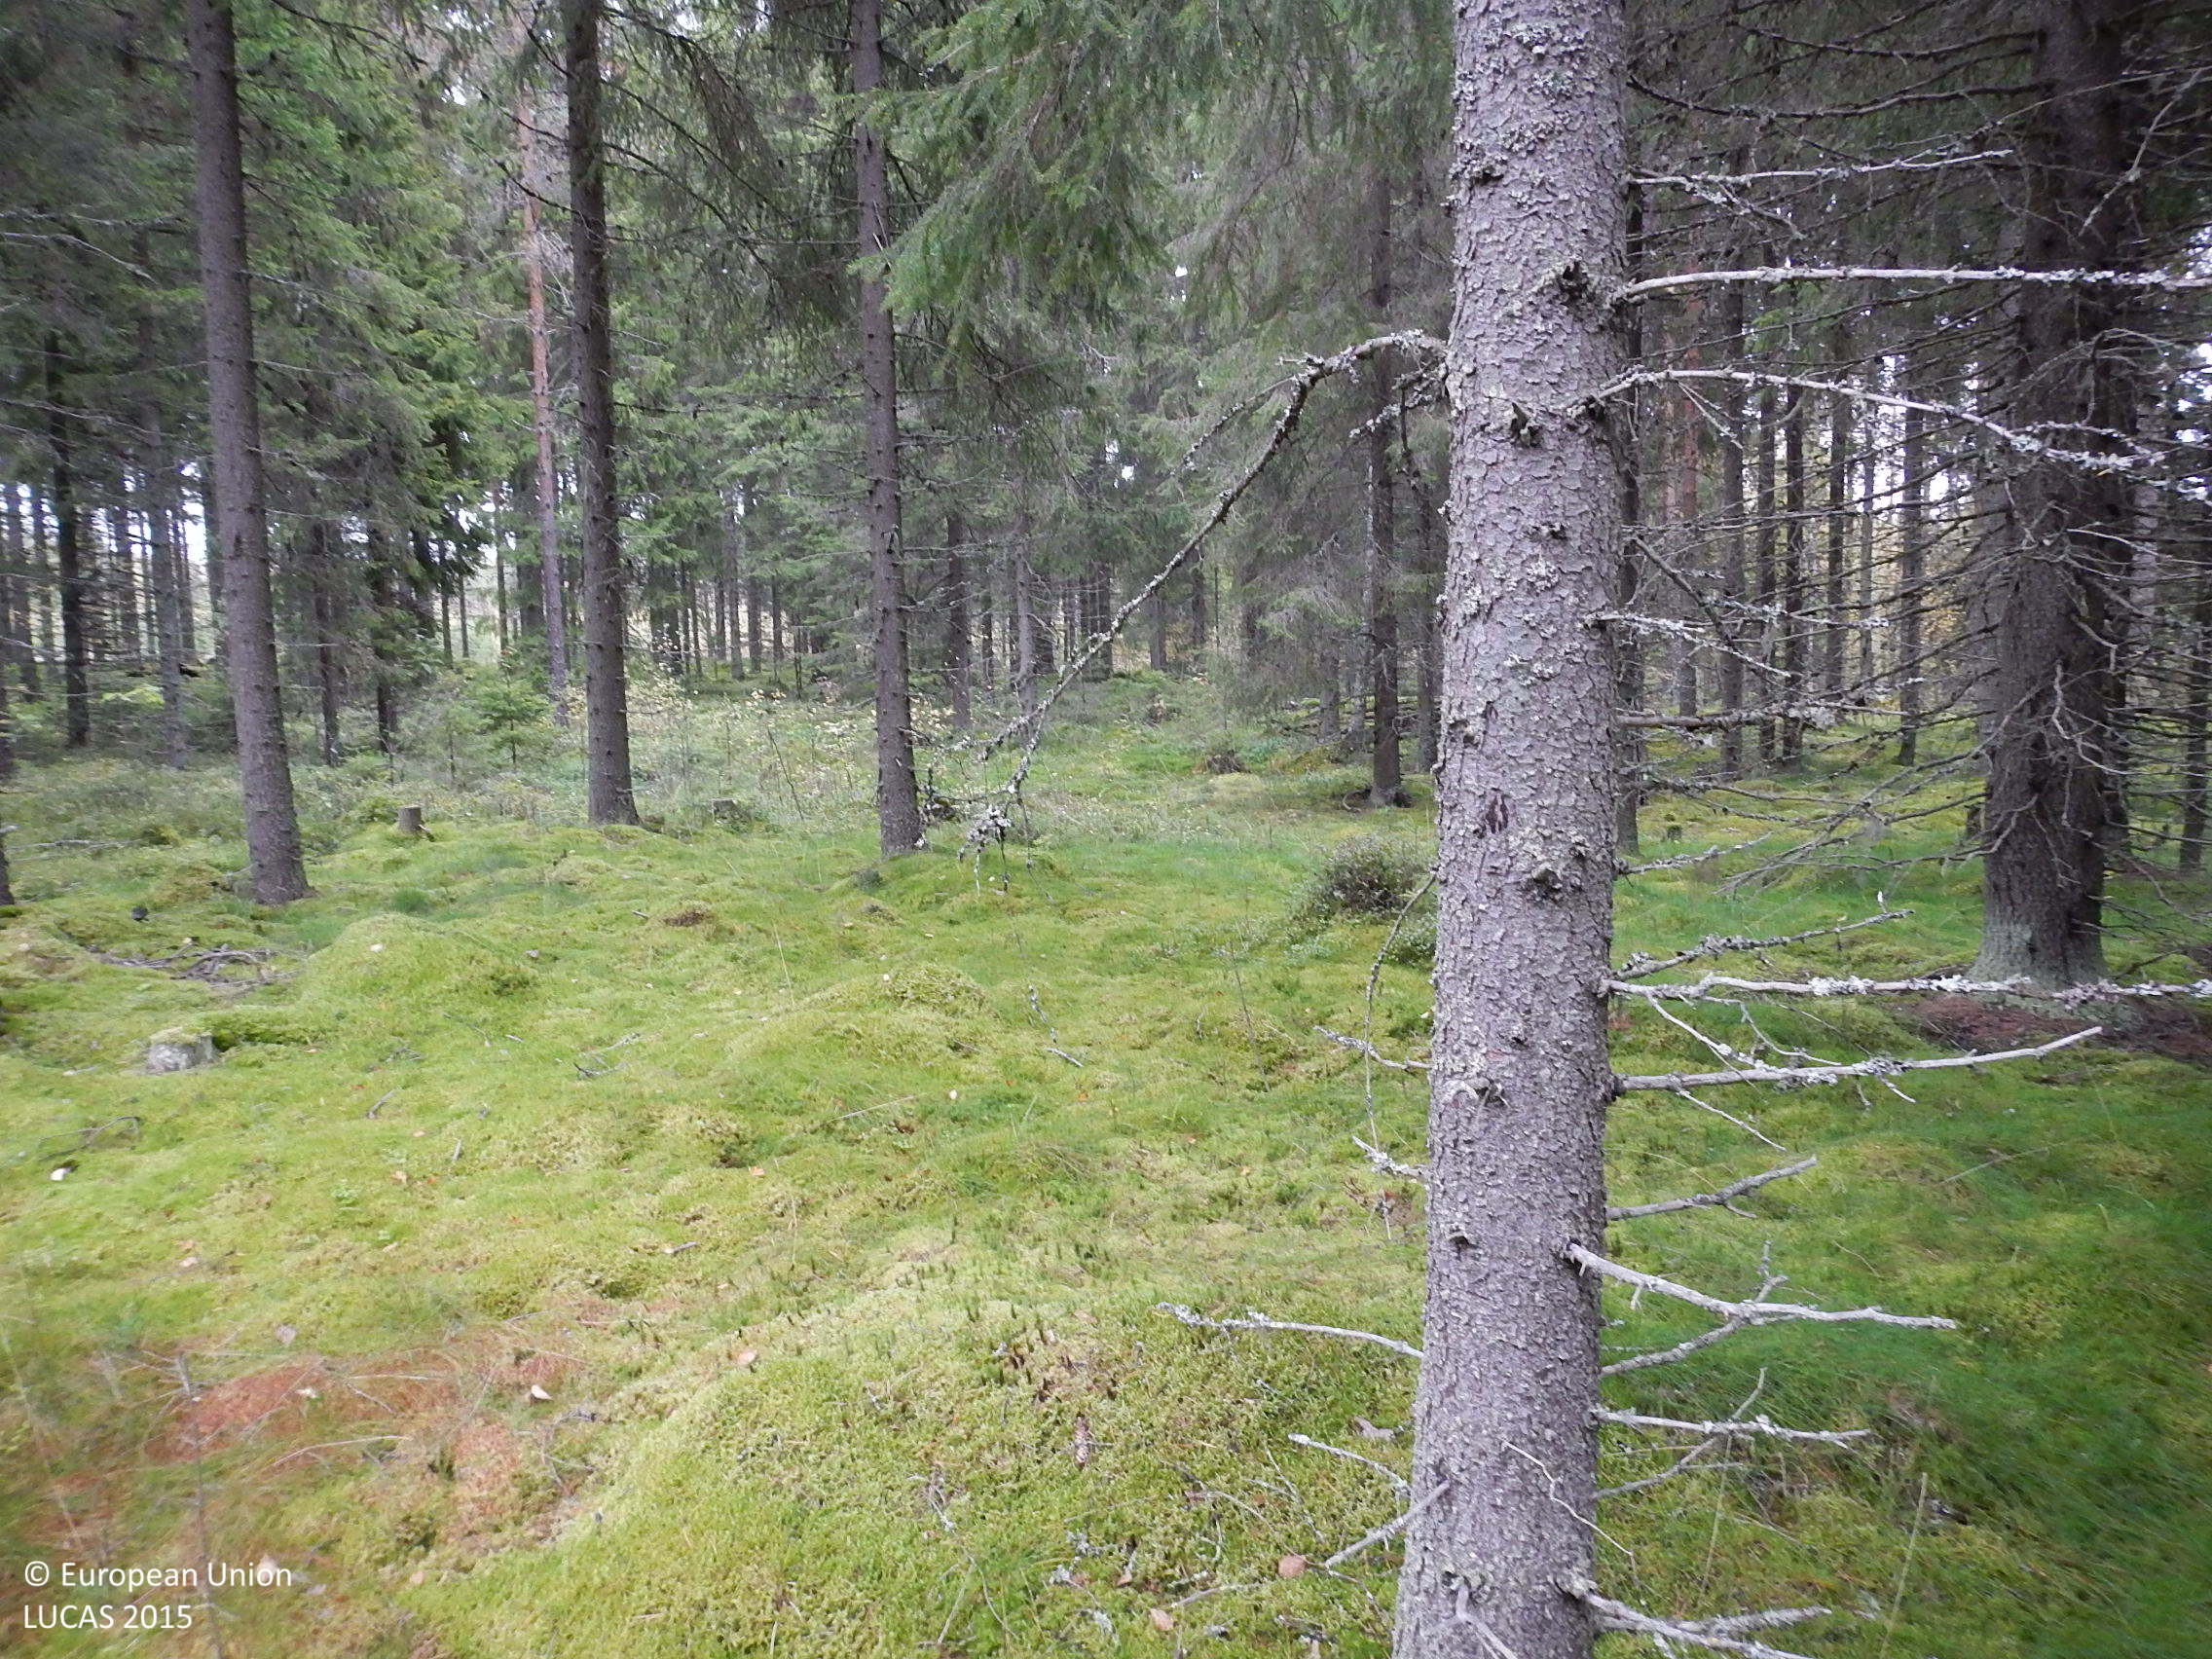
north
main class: Woodland
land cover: Spruce dominated coniferous woodland
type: boreal forest
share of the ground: > 75 %
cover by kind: coniferous forest trees 80 %, shrubs 10 %, lichens and mosses 10 %
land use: Forestry
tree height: > 5 m
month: September
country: FI
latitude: 61.9630
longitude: 22.9004
